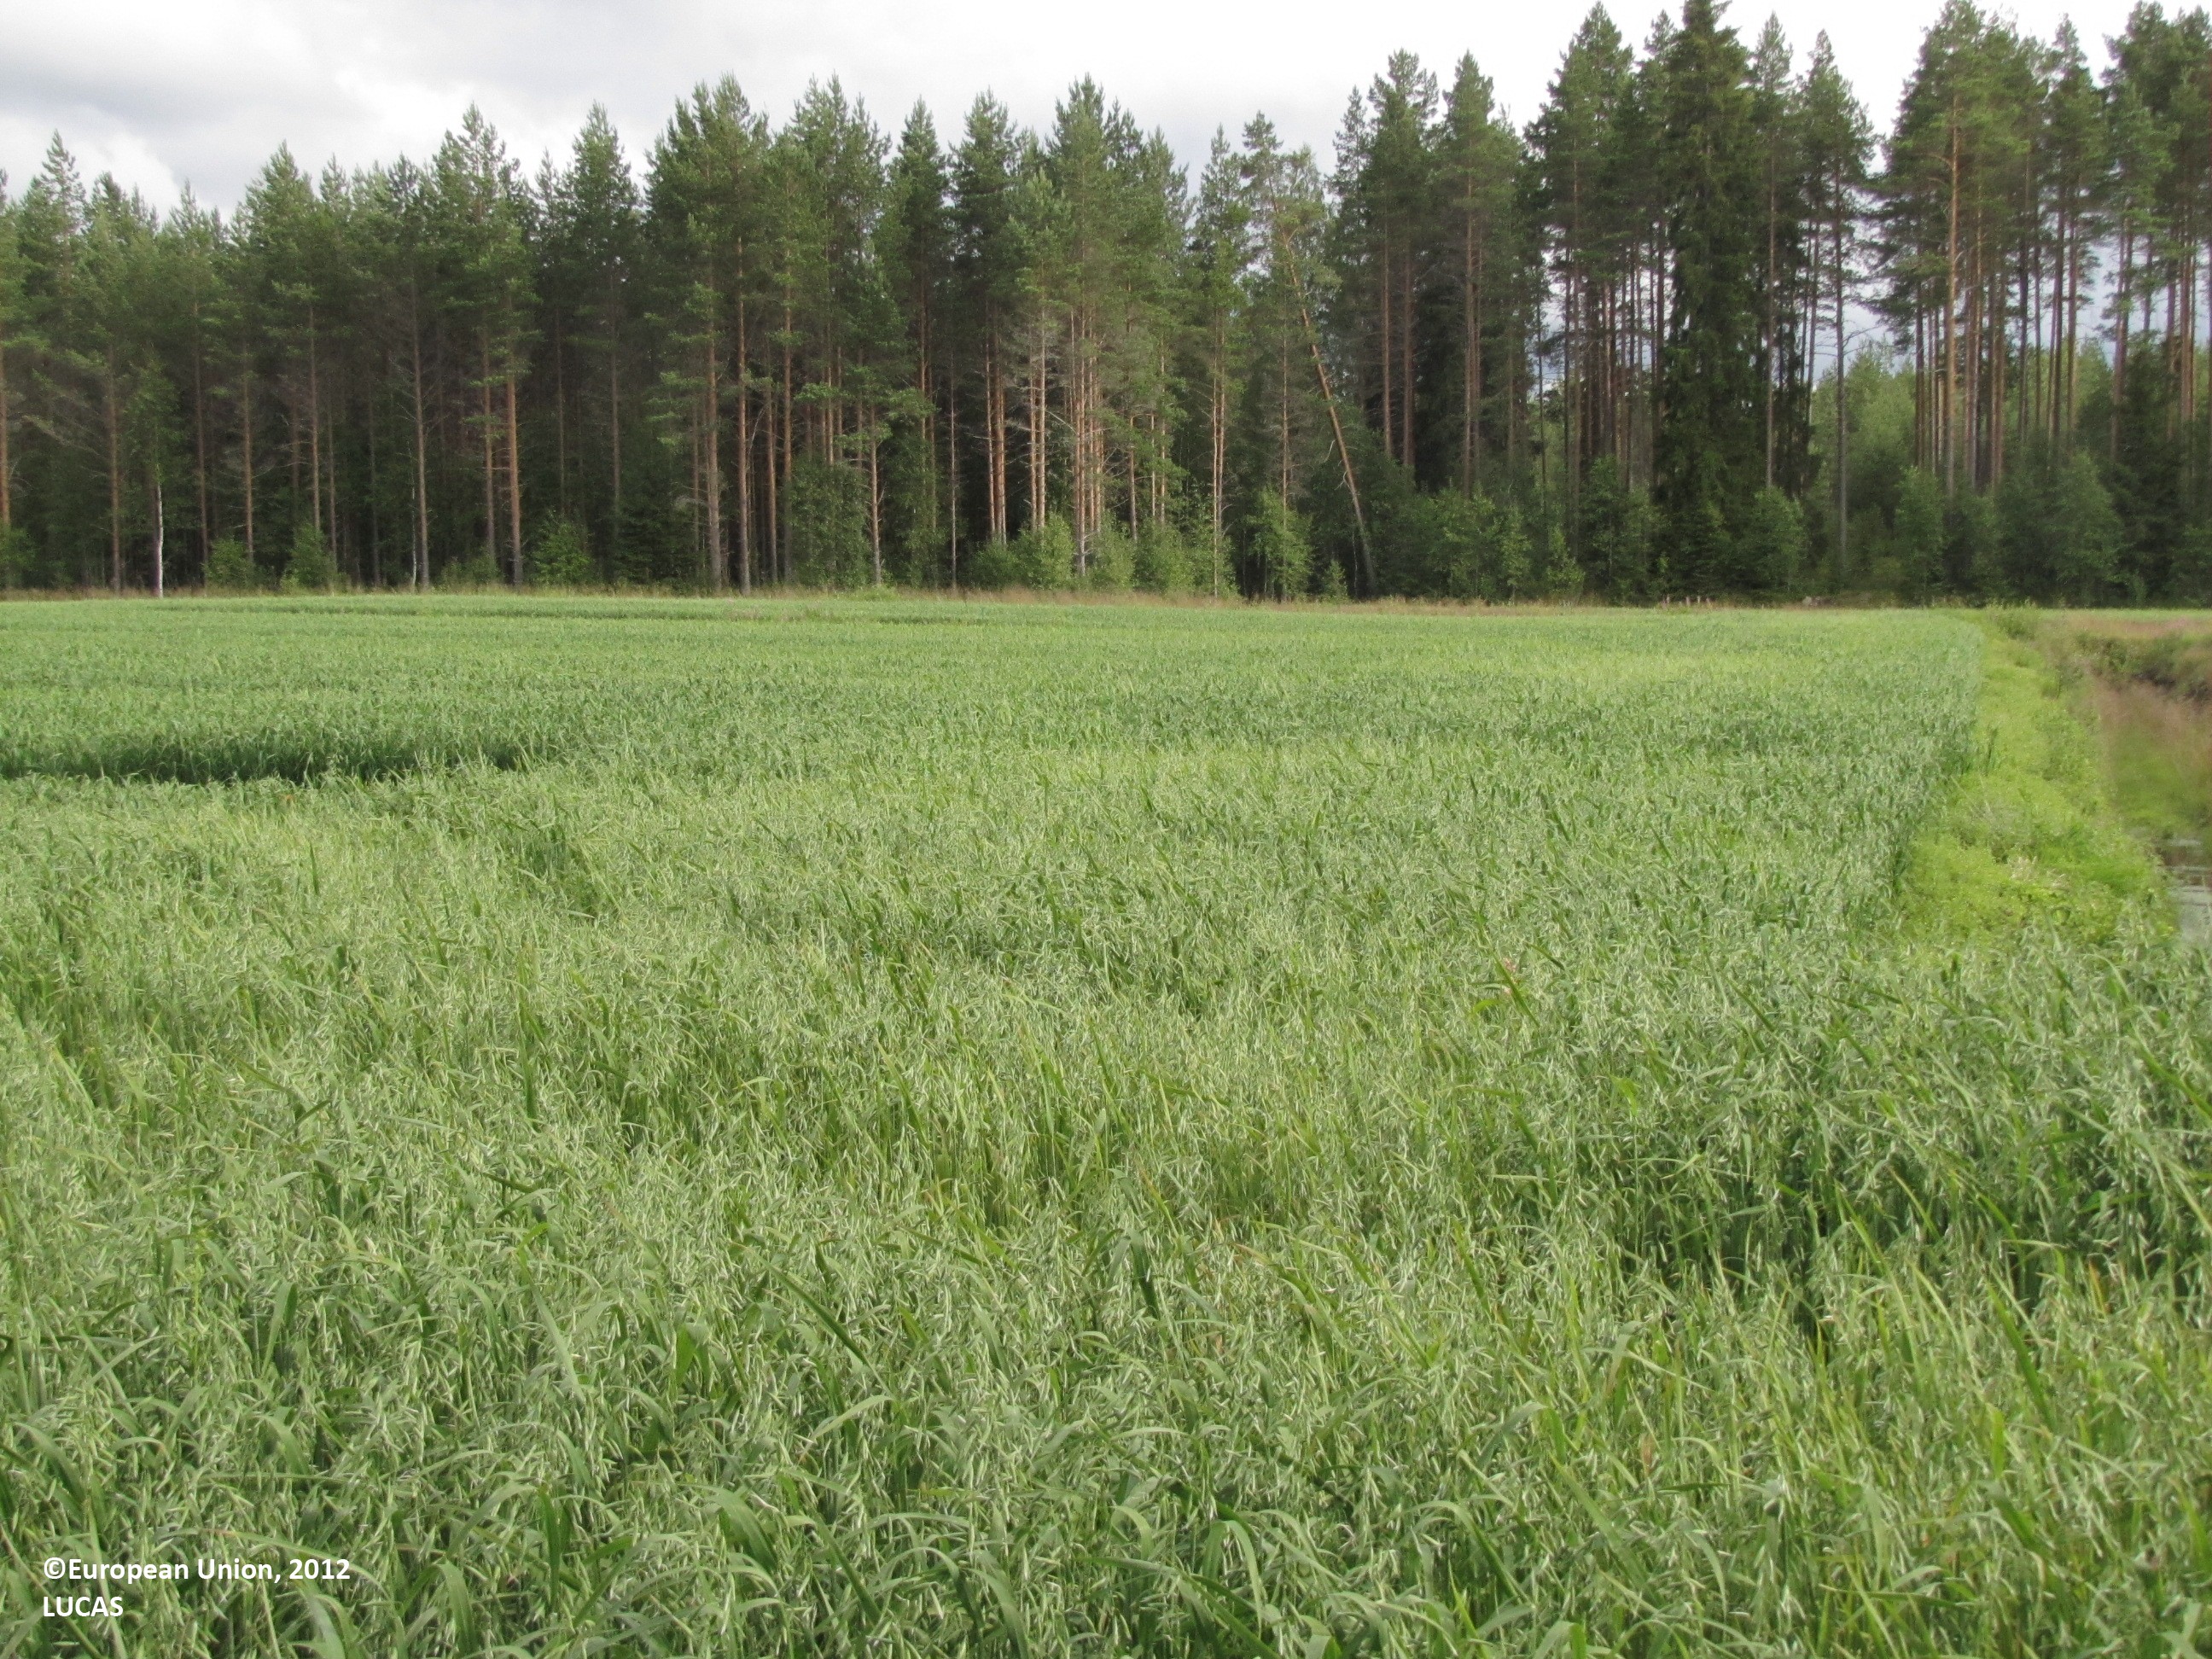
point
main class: Cropland
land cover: Oats
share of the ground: > 75 %
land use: Agriculture (excluding fallow land and kitchen gardens)
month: July
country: FI
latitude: 62.2742
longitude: 23.1105
